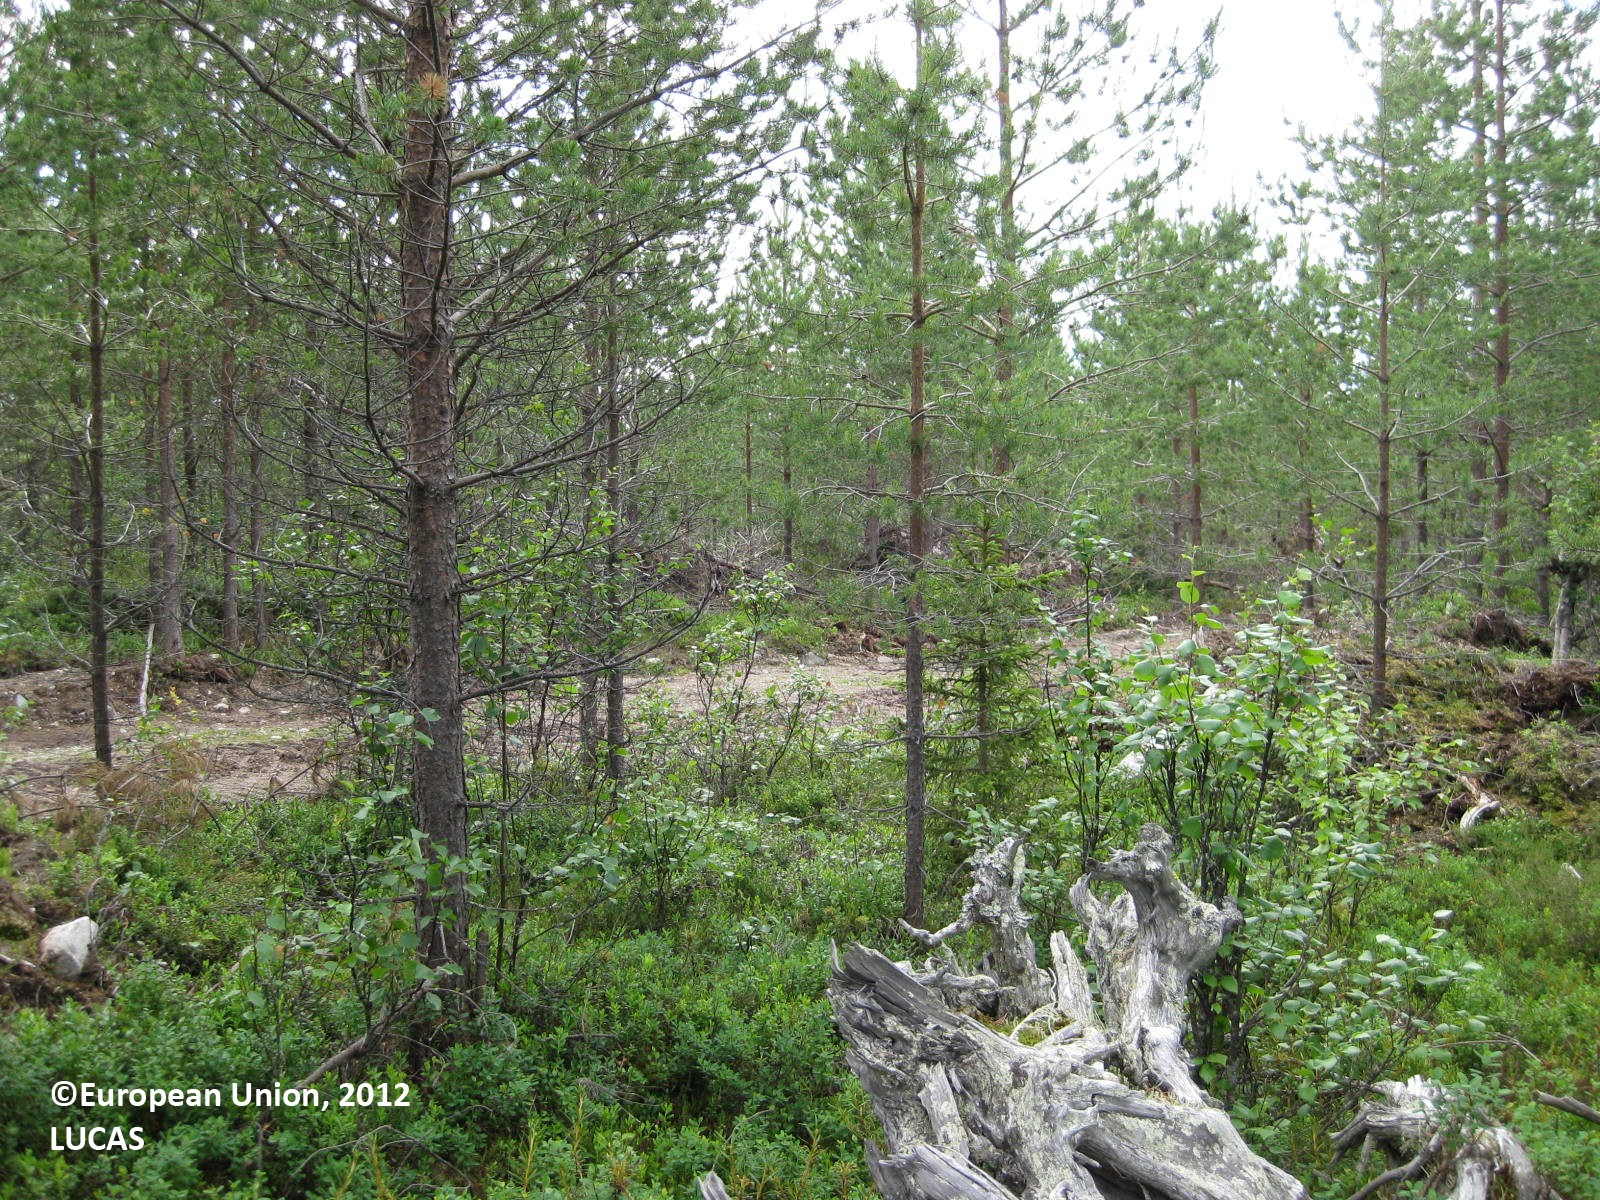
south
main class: Woodland
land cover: Pine dominated coniferous woodland
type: boreal forest
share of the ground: > 75 %
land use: Forestry
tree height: > 5 m
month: July
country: FI
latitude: 65.6555
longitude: 29.2529
